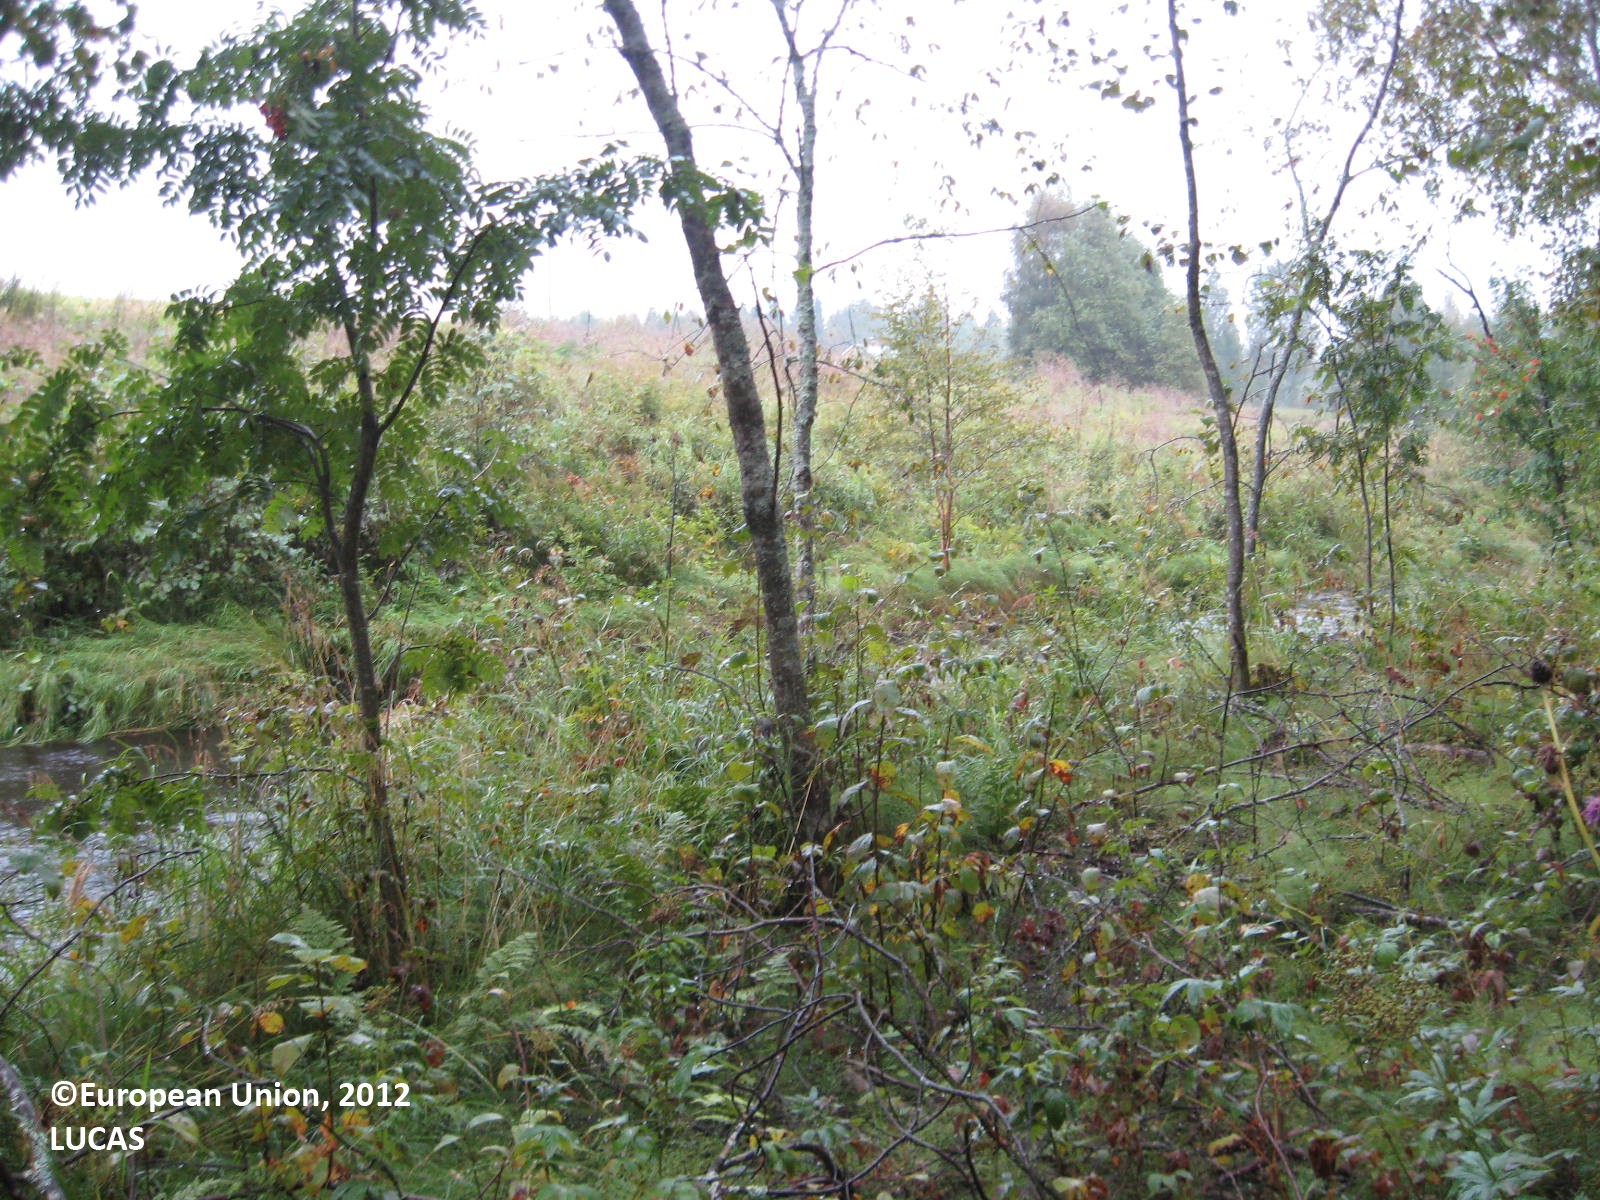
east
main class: Woodland
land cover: Other mixed woodland
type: boreal forest
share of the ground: > 75 %
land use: Forestry
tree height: > 5 m
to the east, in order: Other mixed woodland; Rivers and streams; Shruby margins; Grassland without tree/shrub cover; Temporary grasslands; Shruby margins; Tracks; Electric lines; Shruby margins; Ditches and canals; Grass margins; Temporary grasslands
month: August
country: FI
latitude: 63.5028
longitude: 29.6605
